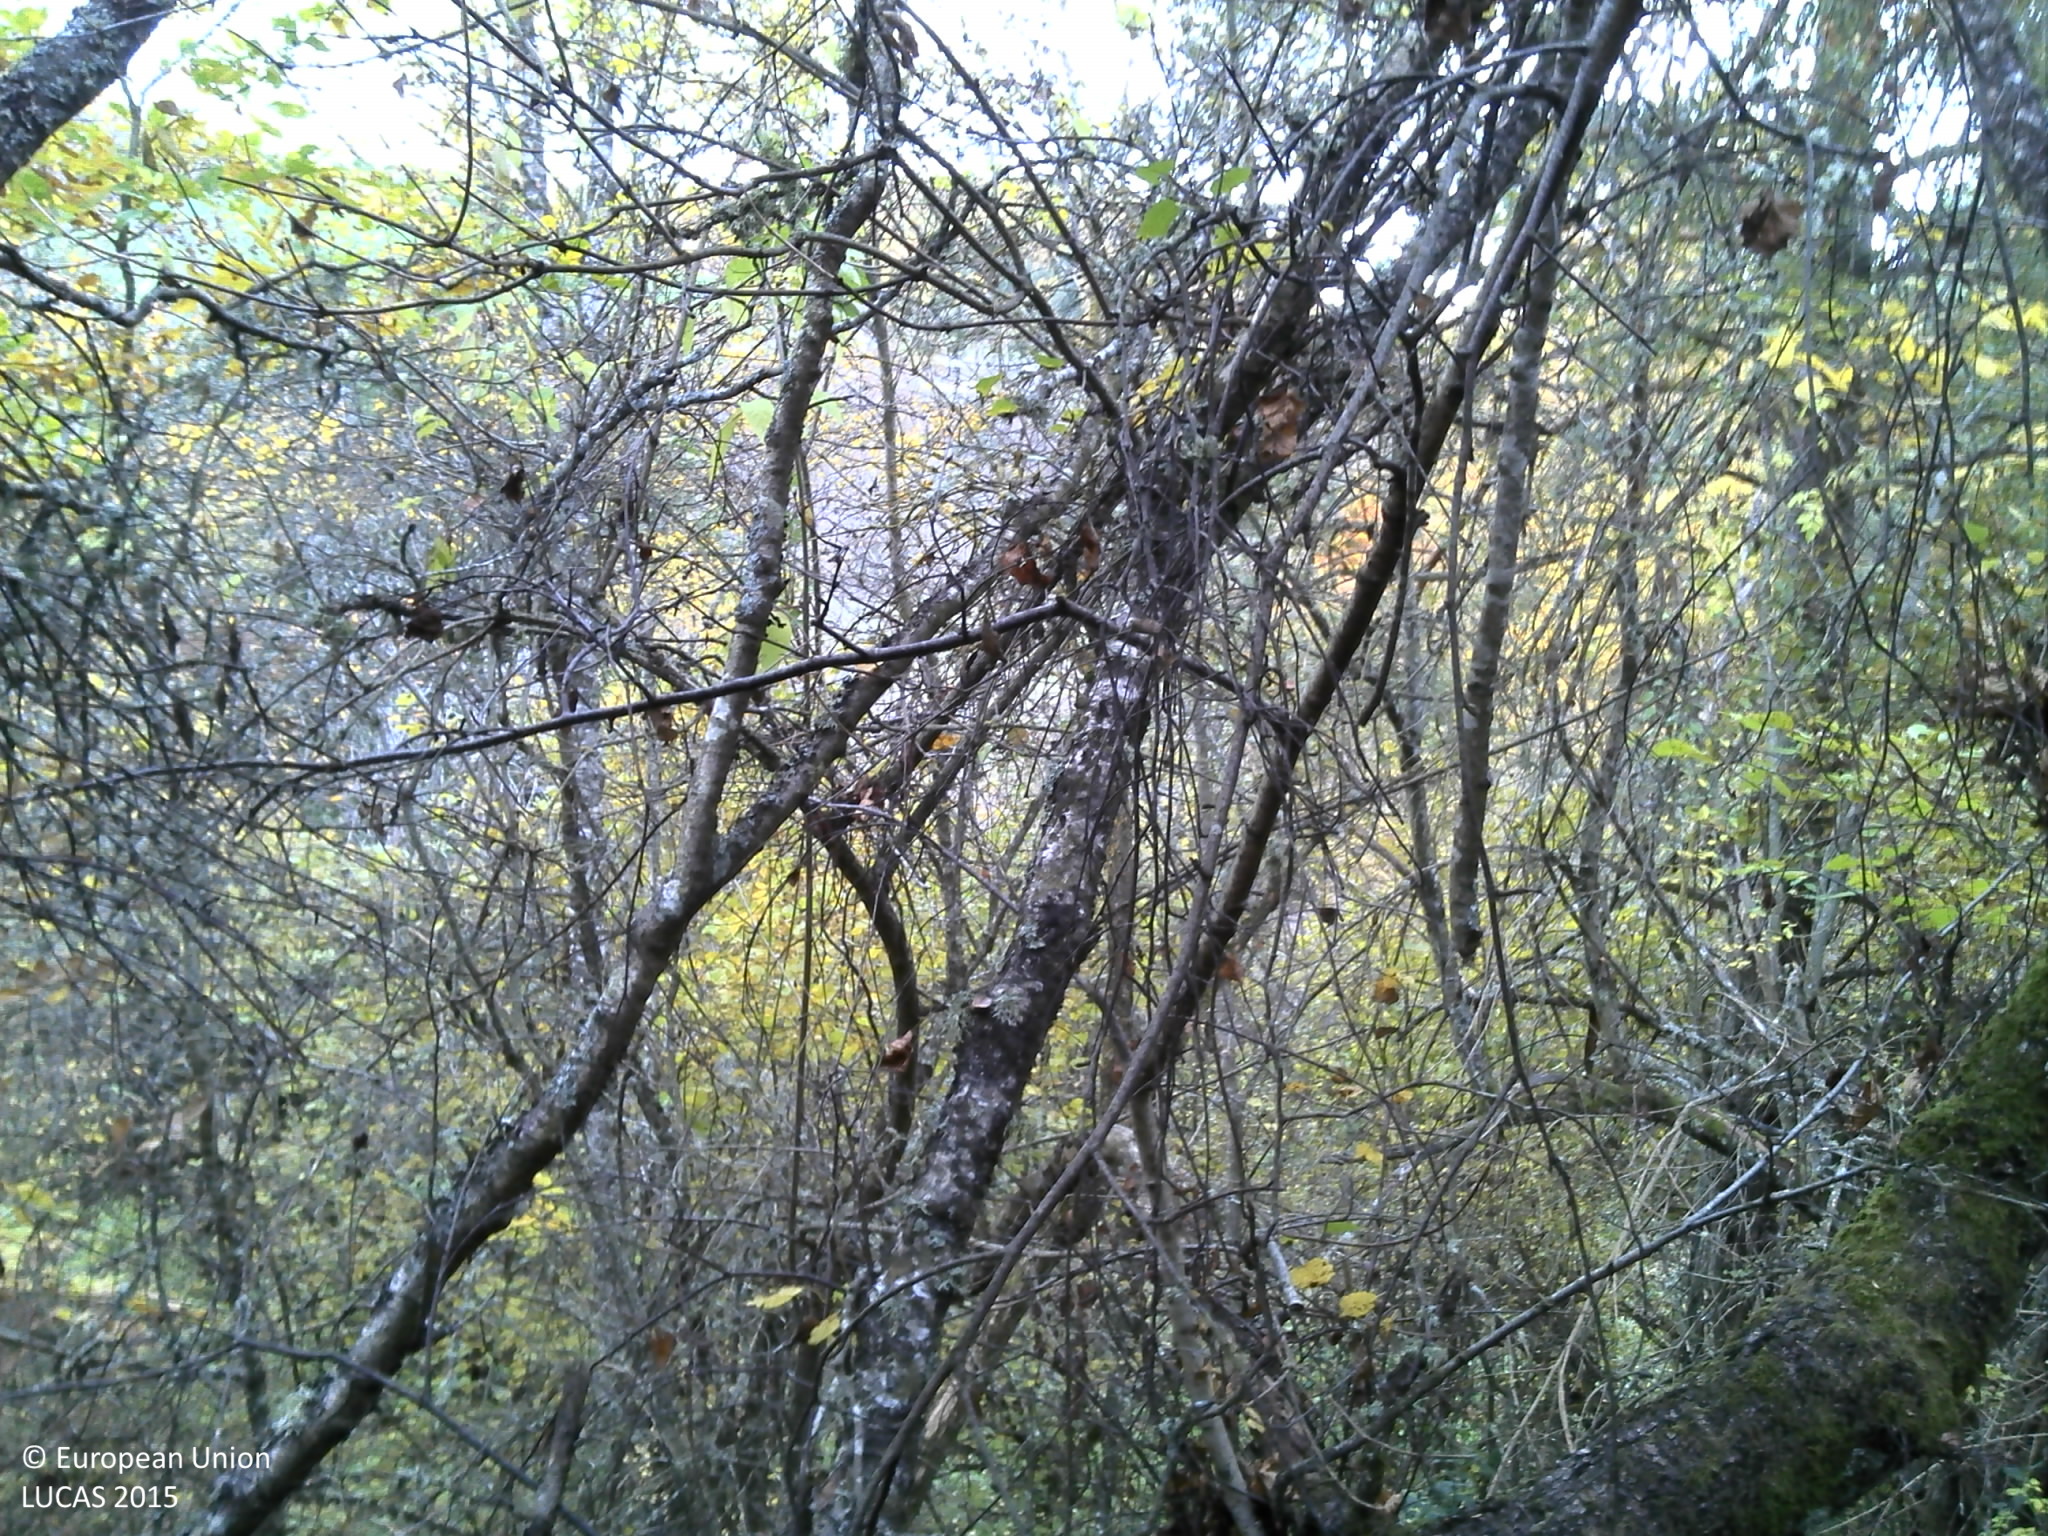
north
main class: Woodland
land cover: Broadleaved woodland
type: non-riverine alder, birch or aspen forest
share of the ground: > 75 %
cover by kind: broadleaved forest trees 70 %, shrubs 30 %
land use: Forestry
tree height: > 5 m
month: October
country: FR
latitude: 45.7853
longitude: 2.8342
